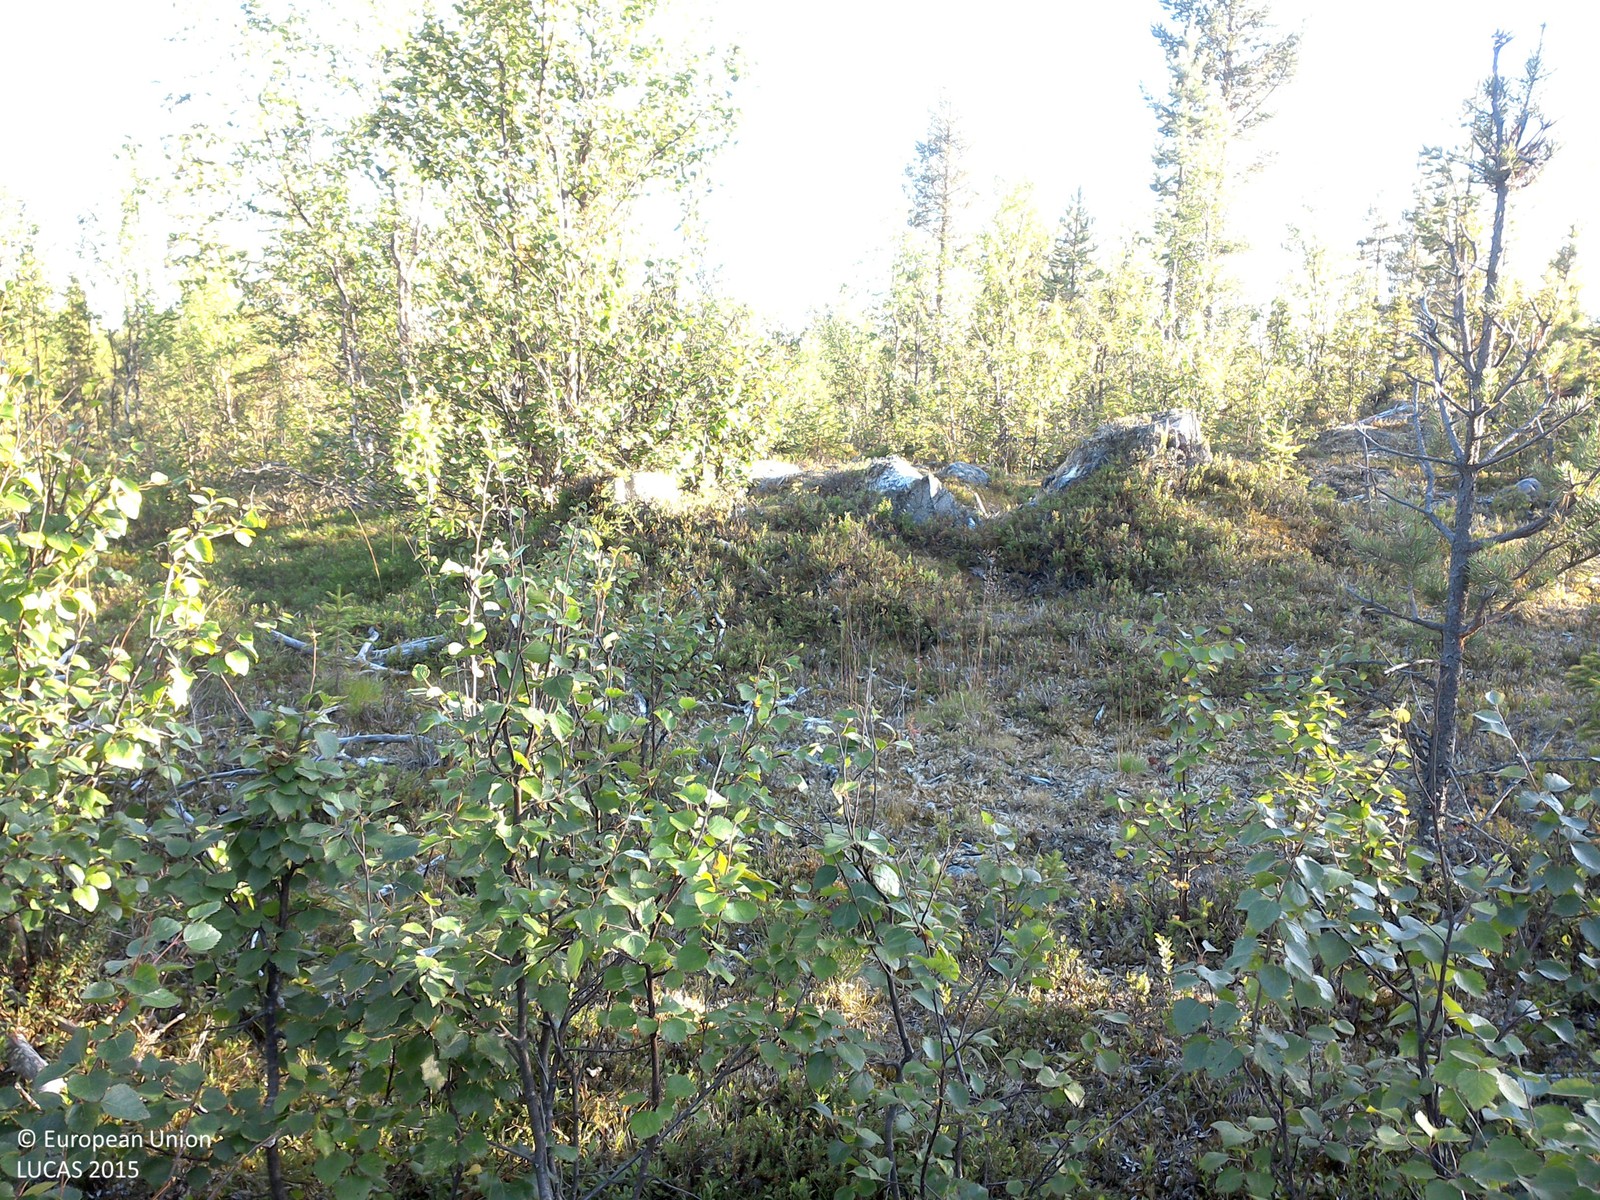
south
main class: Woodland
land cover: Other mixed woodland
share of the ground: 10 - 25 %
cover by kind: shrubs 50 %, lichens and mosses 25 %, broadleaved forest trees 15 %, coniferous forest trees 10 %
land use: Forestry
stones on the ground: 10 - 25 %
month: August
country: SE
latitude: 67.4372
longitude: 20.9942
